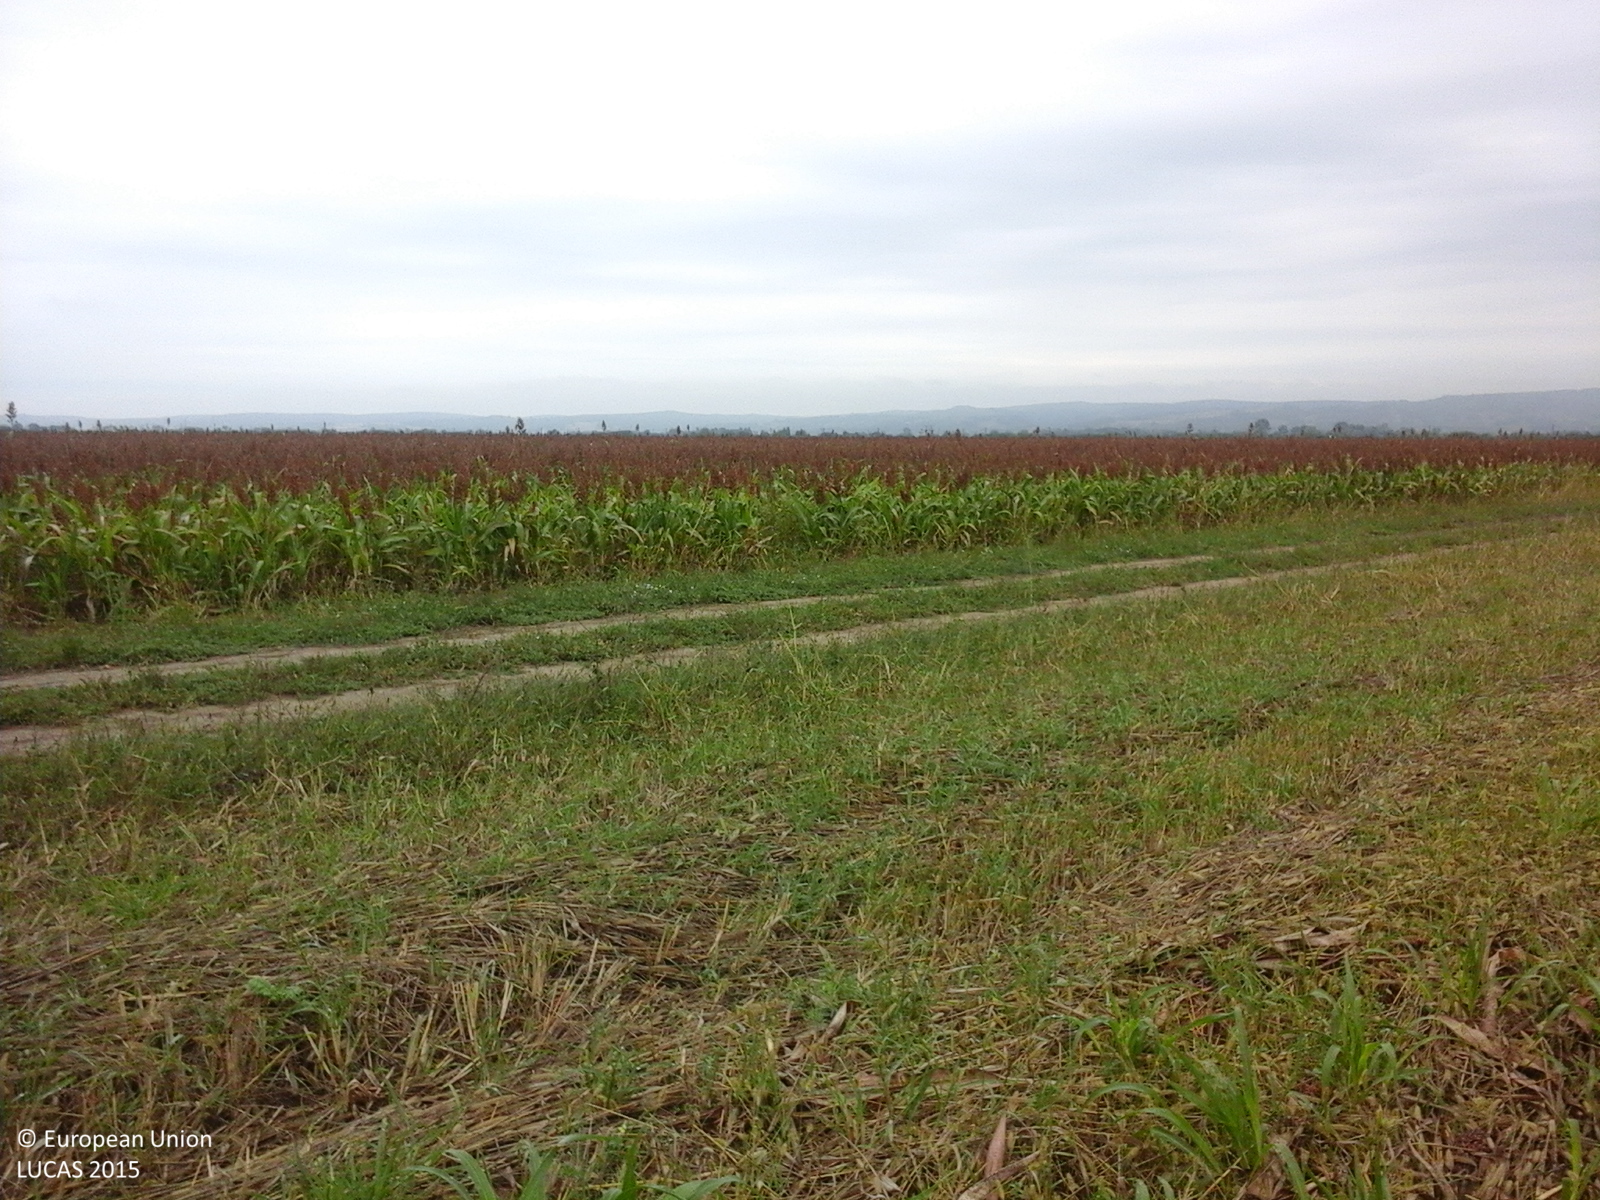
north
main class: Cropland
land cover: Other cereals
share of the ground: > 75 %
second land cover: Spontaneously vegetated surfaces
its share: 25 - 50 %
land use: Agriculture (excluding fallow land and kitchen gardens)
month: September
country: RO
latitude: 45.5942
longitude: 22.0512
